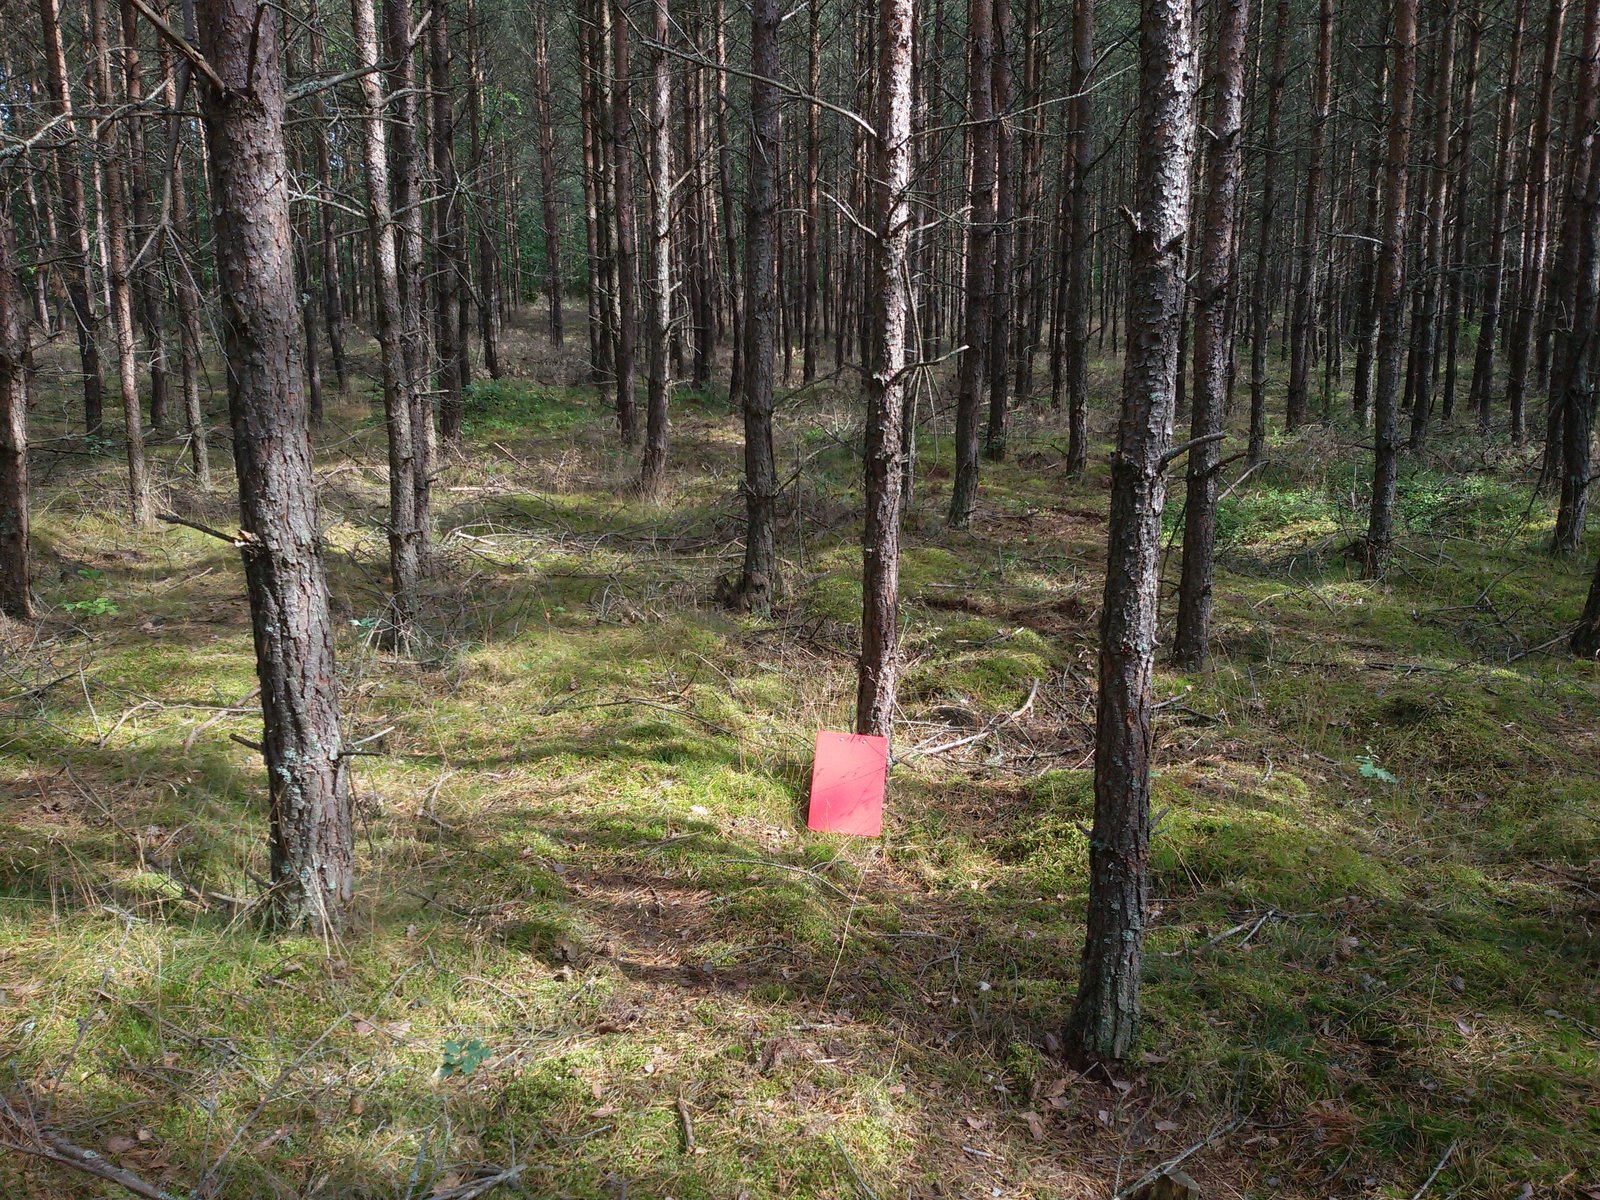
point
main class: Woodland
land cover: Pine dominated coniferous woodland
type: hemiboreal forest and nemoral coniferous forest and mixed broadleaved-coniferous forest
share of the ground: > 75 %
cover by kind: coniferous forest trees 85 %, lichens and mosses 10 %, unconsolidated bare surface 5 %
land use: Forestry
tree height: > 5 m
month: August
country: PL
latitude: 53.6427
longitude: 17.1341
